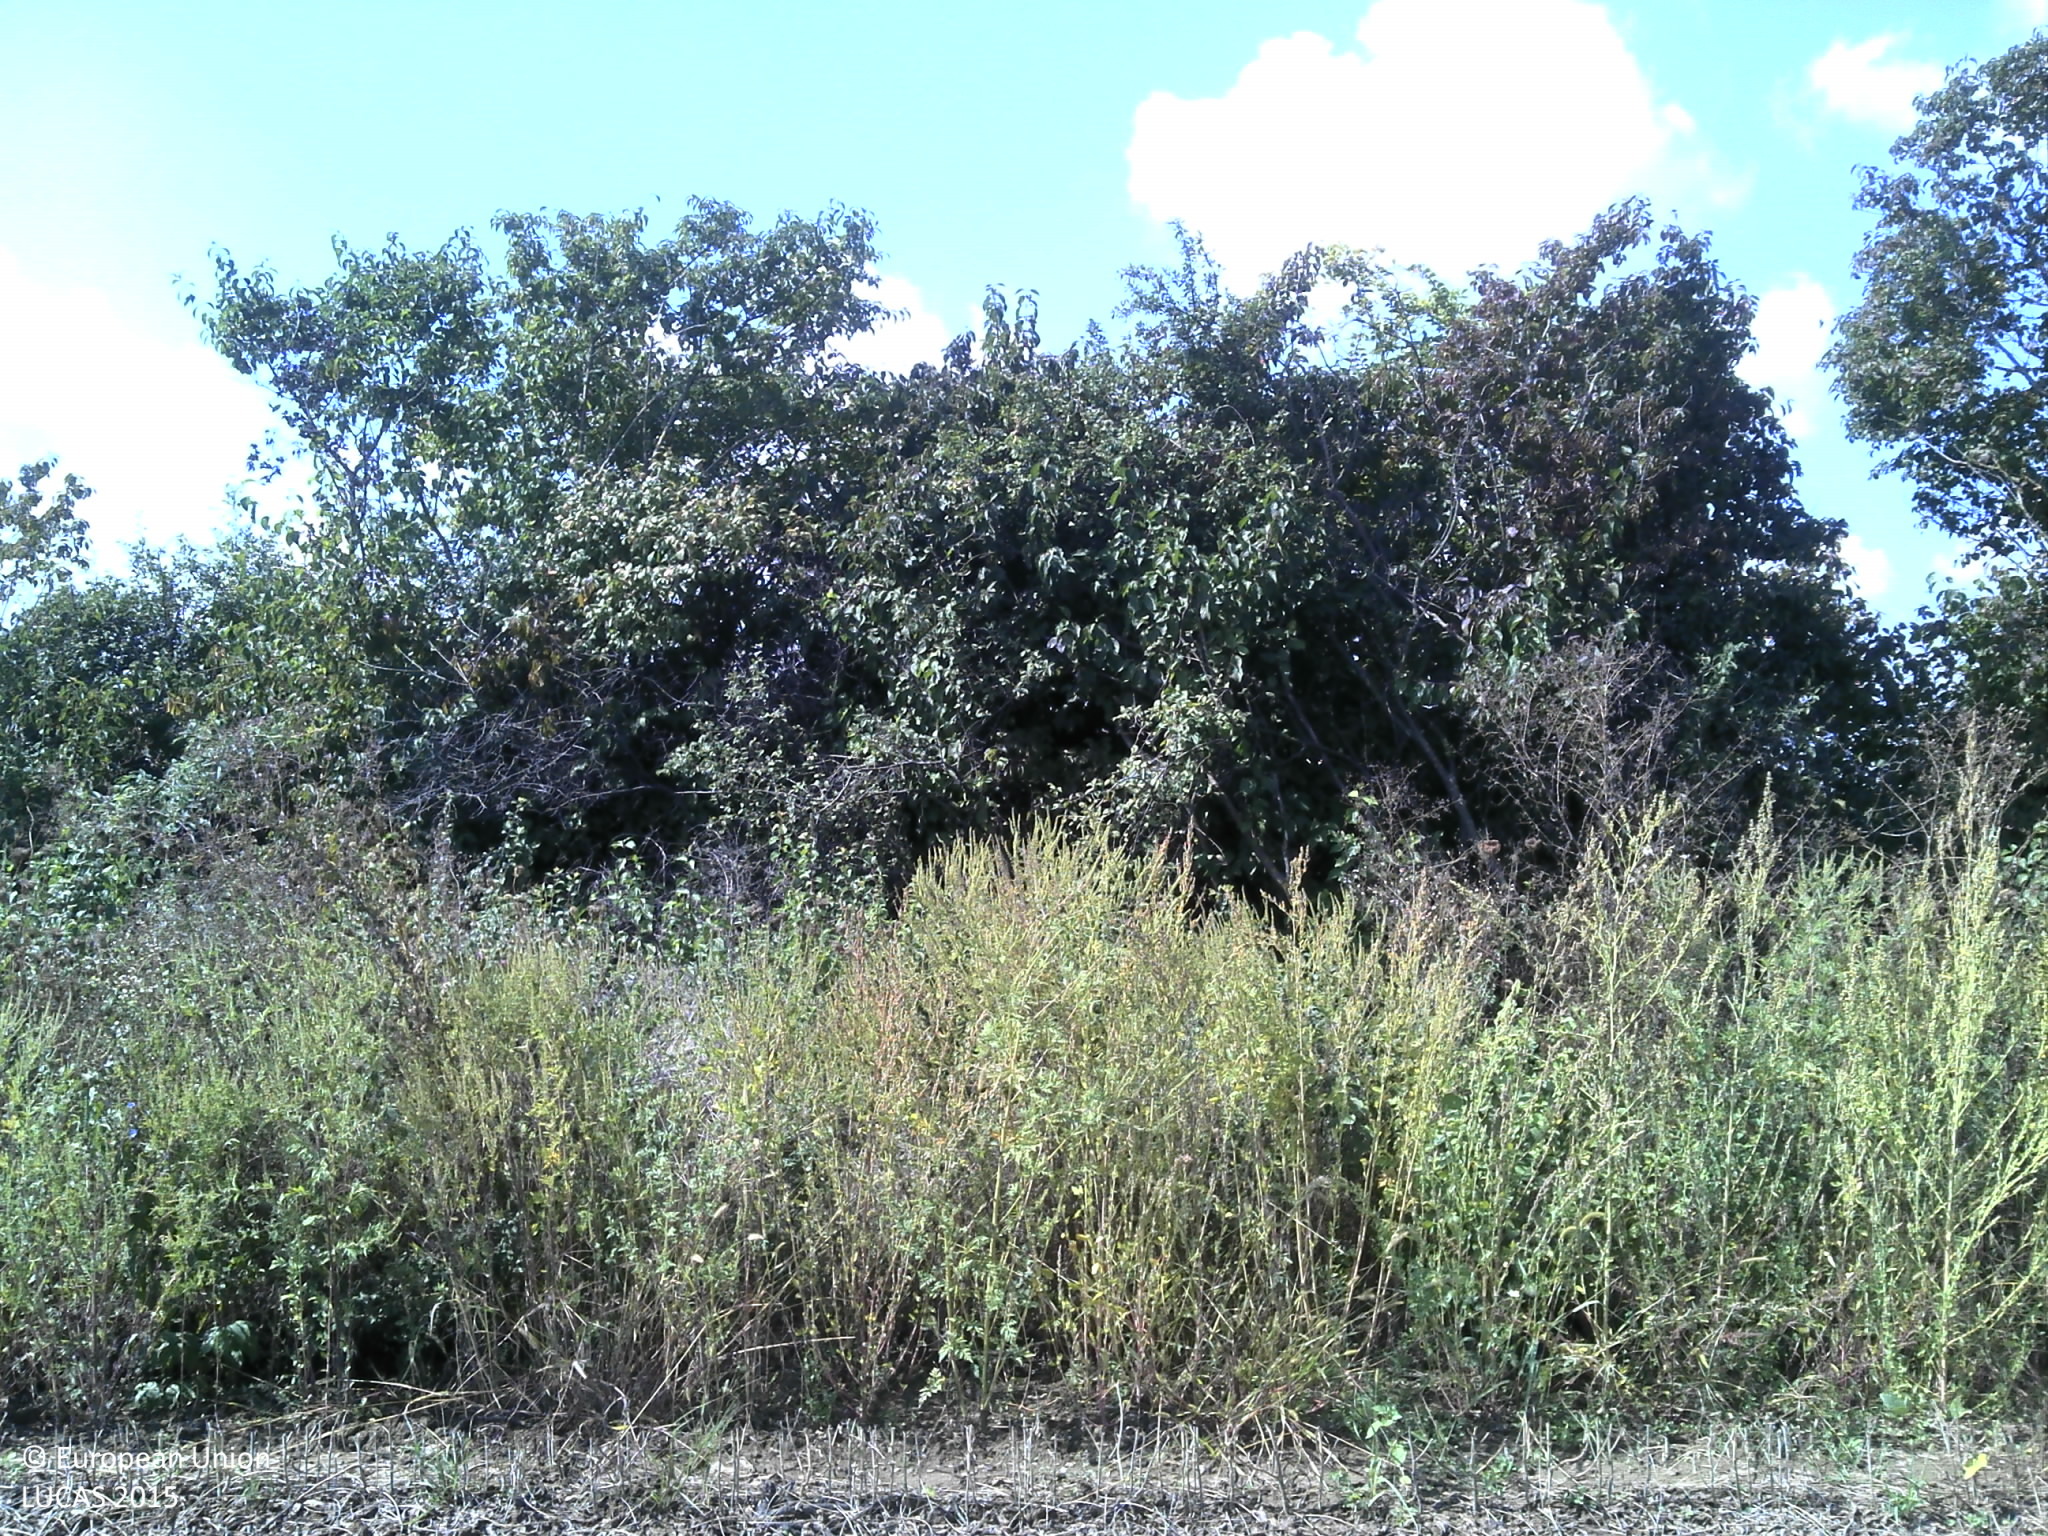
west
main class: Cropland
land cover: Soya
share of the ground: < 10 %
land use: Agriculture (excluding fallow land and kitchen gardens)
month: September
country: HR
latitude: 45.1398
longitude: 18.9730
